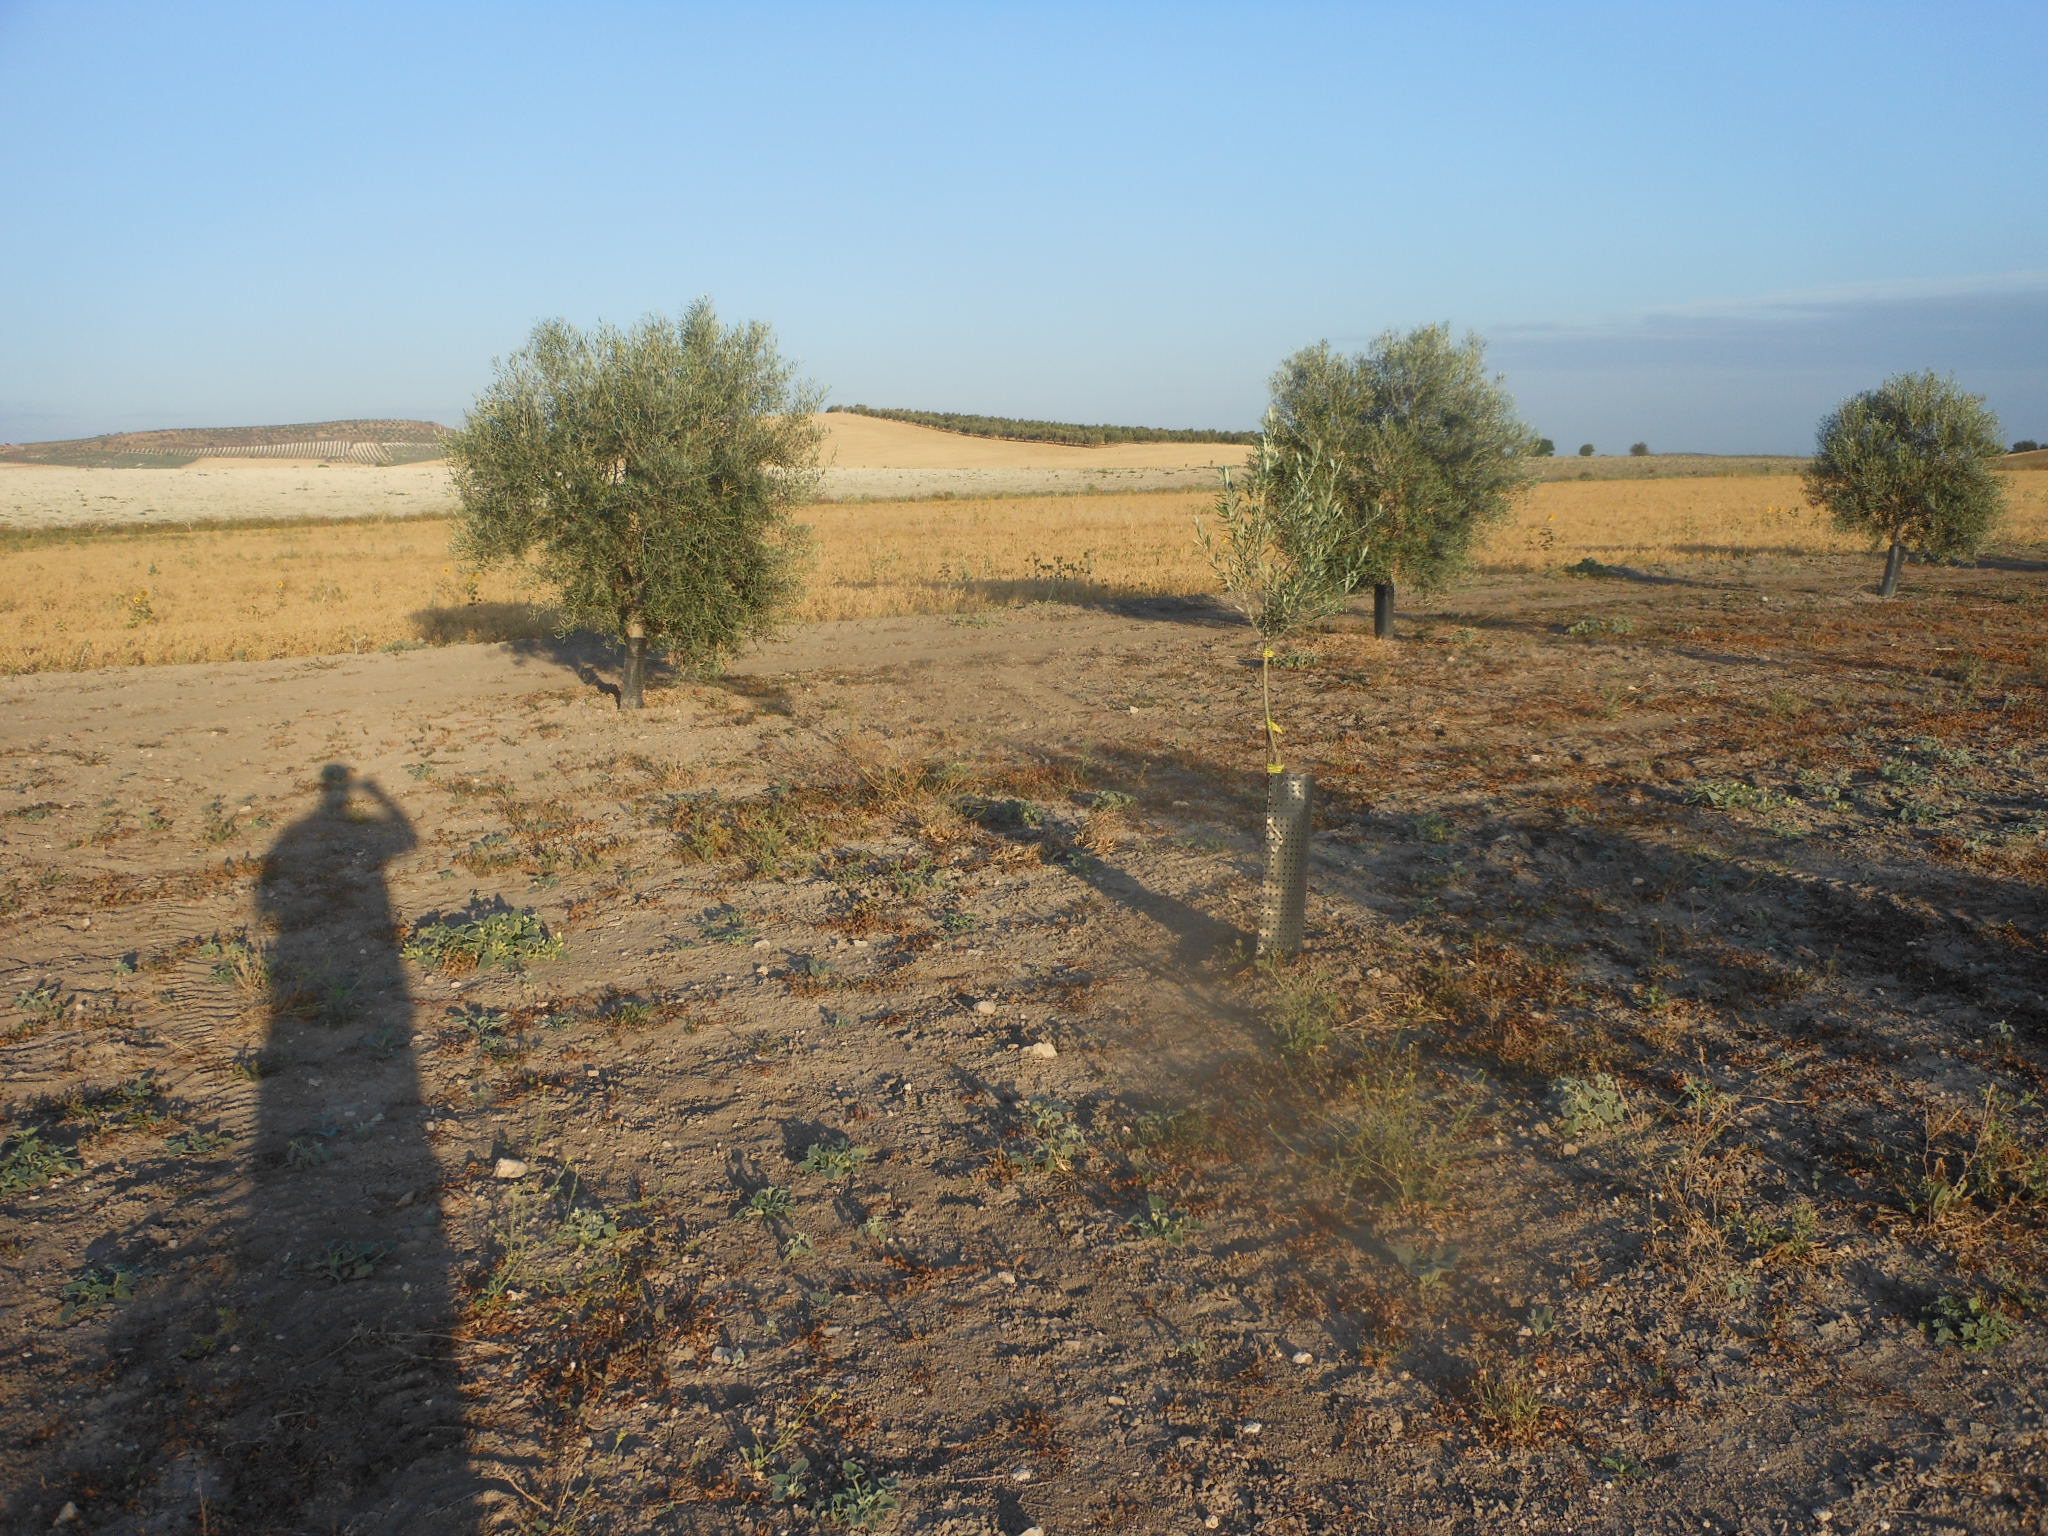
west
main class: Cropland
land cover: Olive groves
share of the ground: 25 - 50 %
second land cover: Spontaneously vegetated surfaces
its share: 10 - 25 %
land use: Agriculture (excluding fallow land and kitchen gardens)
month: June
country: ES
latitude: 37.2587
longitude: -5.0599
